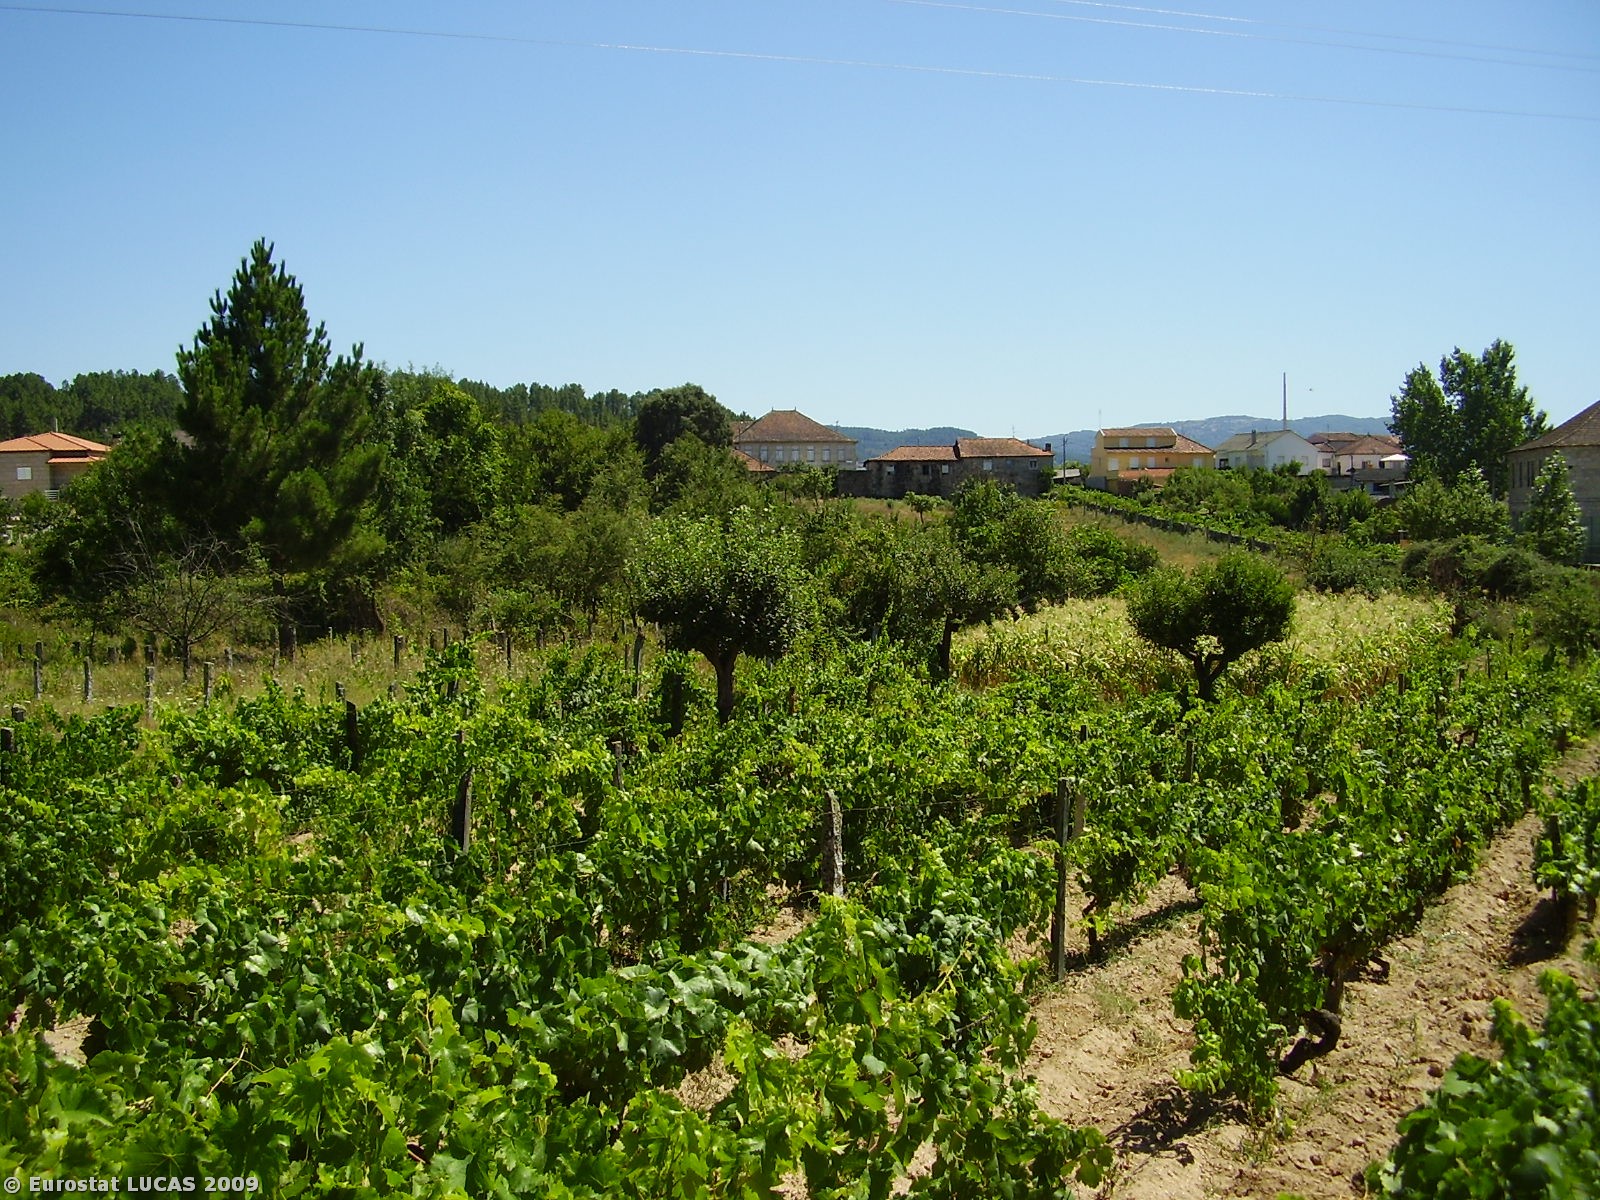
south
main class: Cropland
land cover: Vineyards
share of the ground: 50 - 75 %
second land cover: Bare land
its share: 10 - 25 %
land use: Agriculture (excluding fallow land and kitchen gardens)
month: July
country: PT
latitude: 41.7939
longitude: -7.4226
